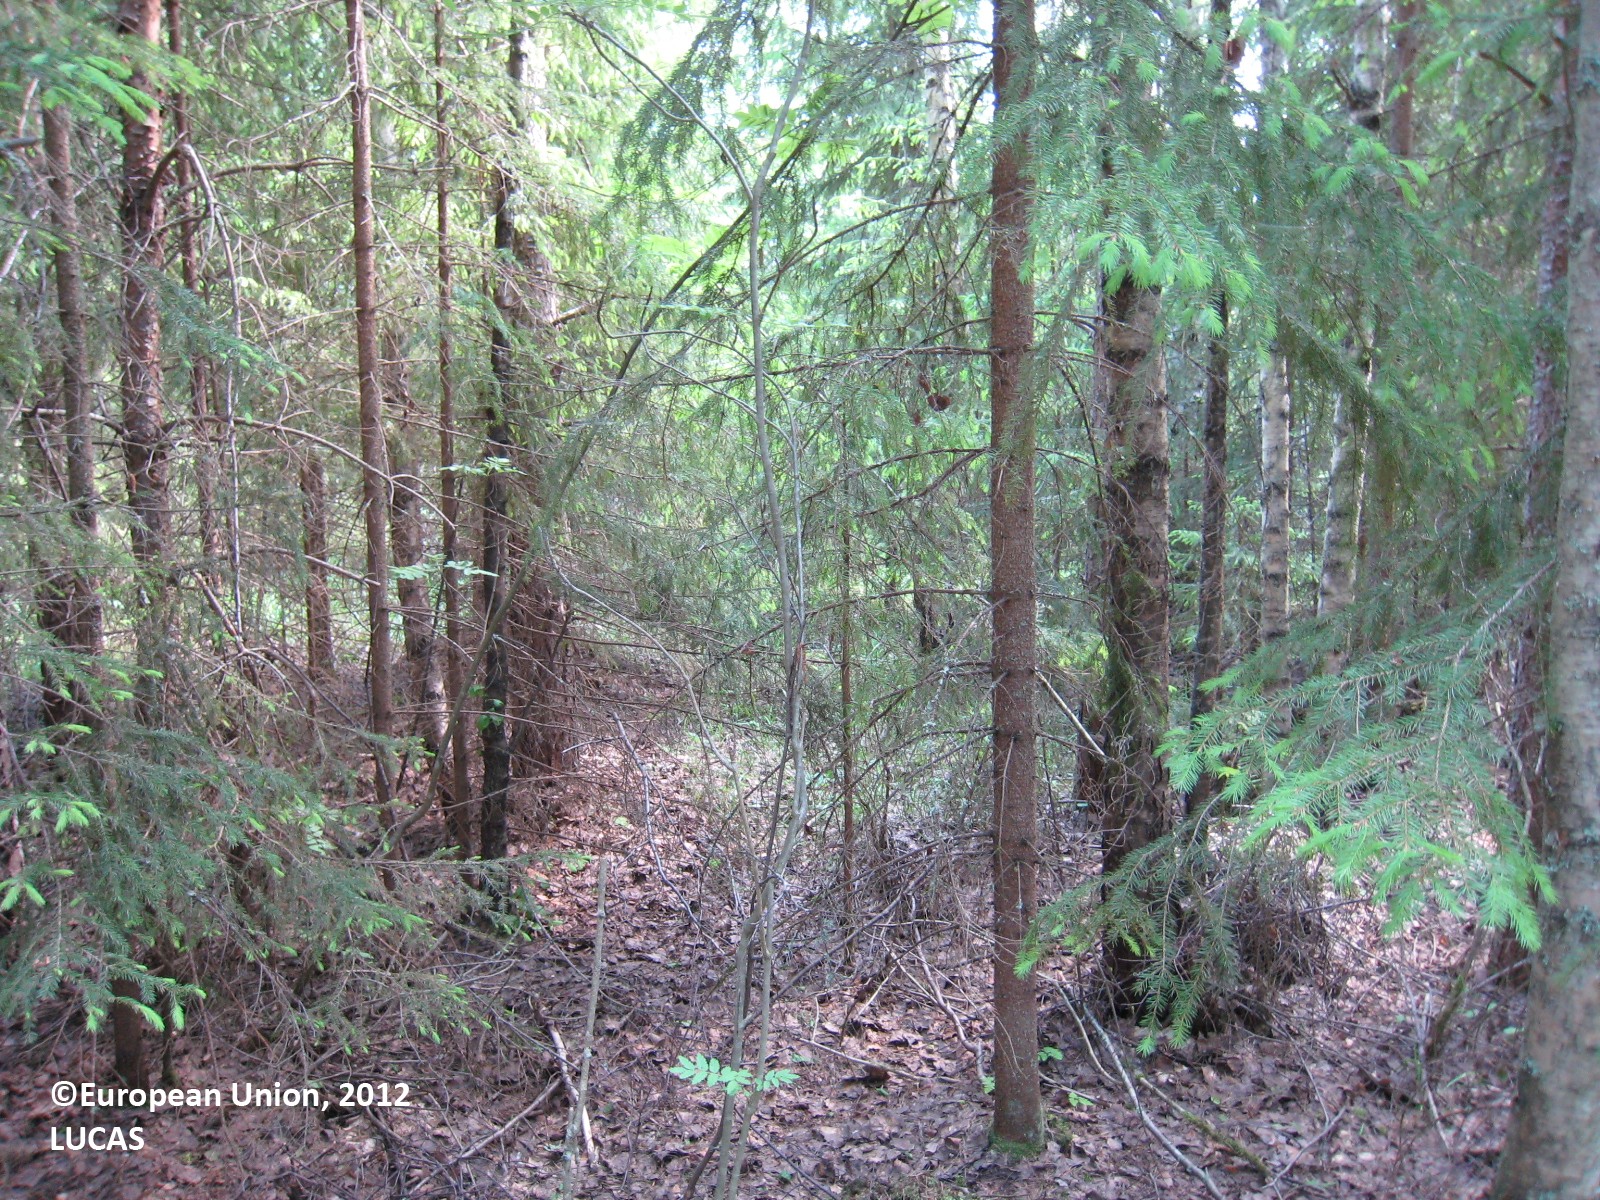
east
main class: Woodland
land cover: Other mixed woodland
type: boreal forest
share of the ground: > 75 %
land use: Forestry
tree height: > 5 m
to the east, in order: Other mixed woodland; Pine dominated mixed woodland; Lichens and moss; Pine dominated mixed woodland; Lichens and moss; Groves; Lichens and moss; Pine dominated mixed woodland
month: June
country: FI
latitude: 62.0874
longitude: 25.7668
